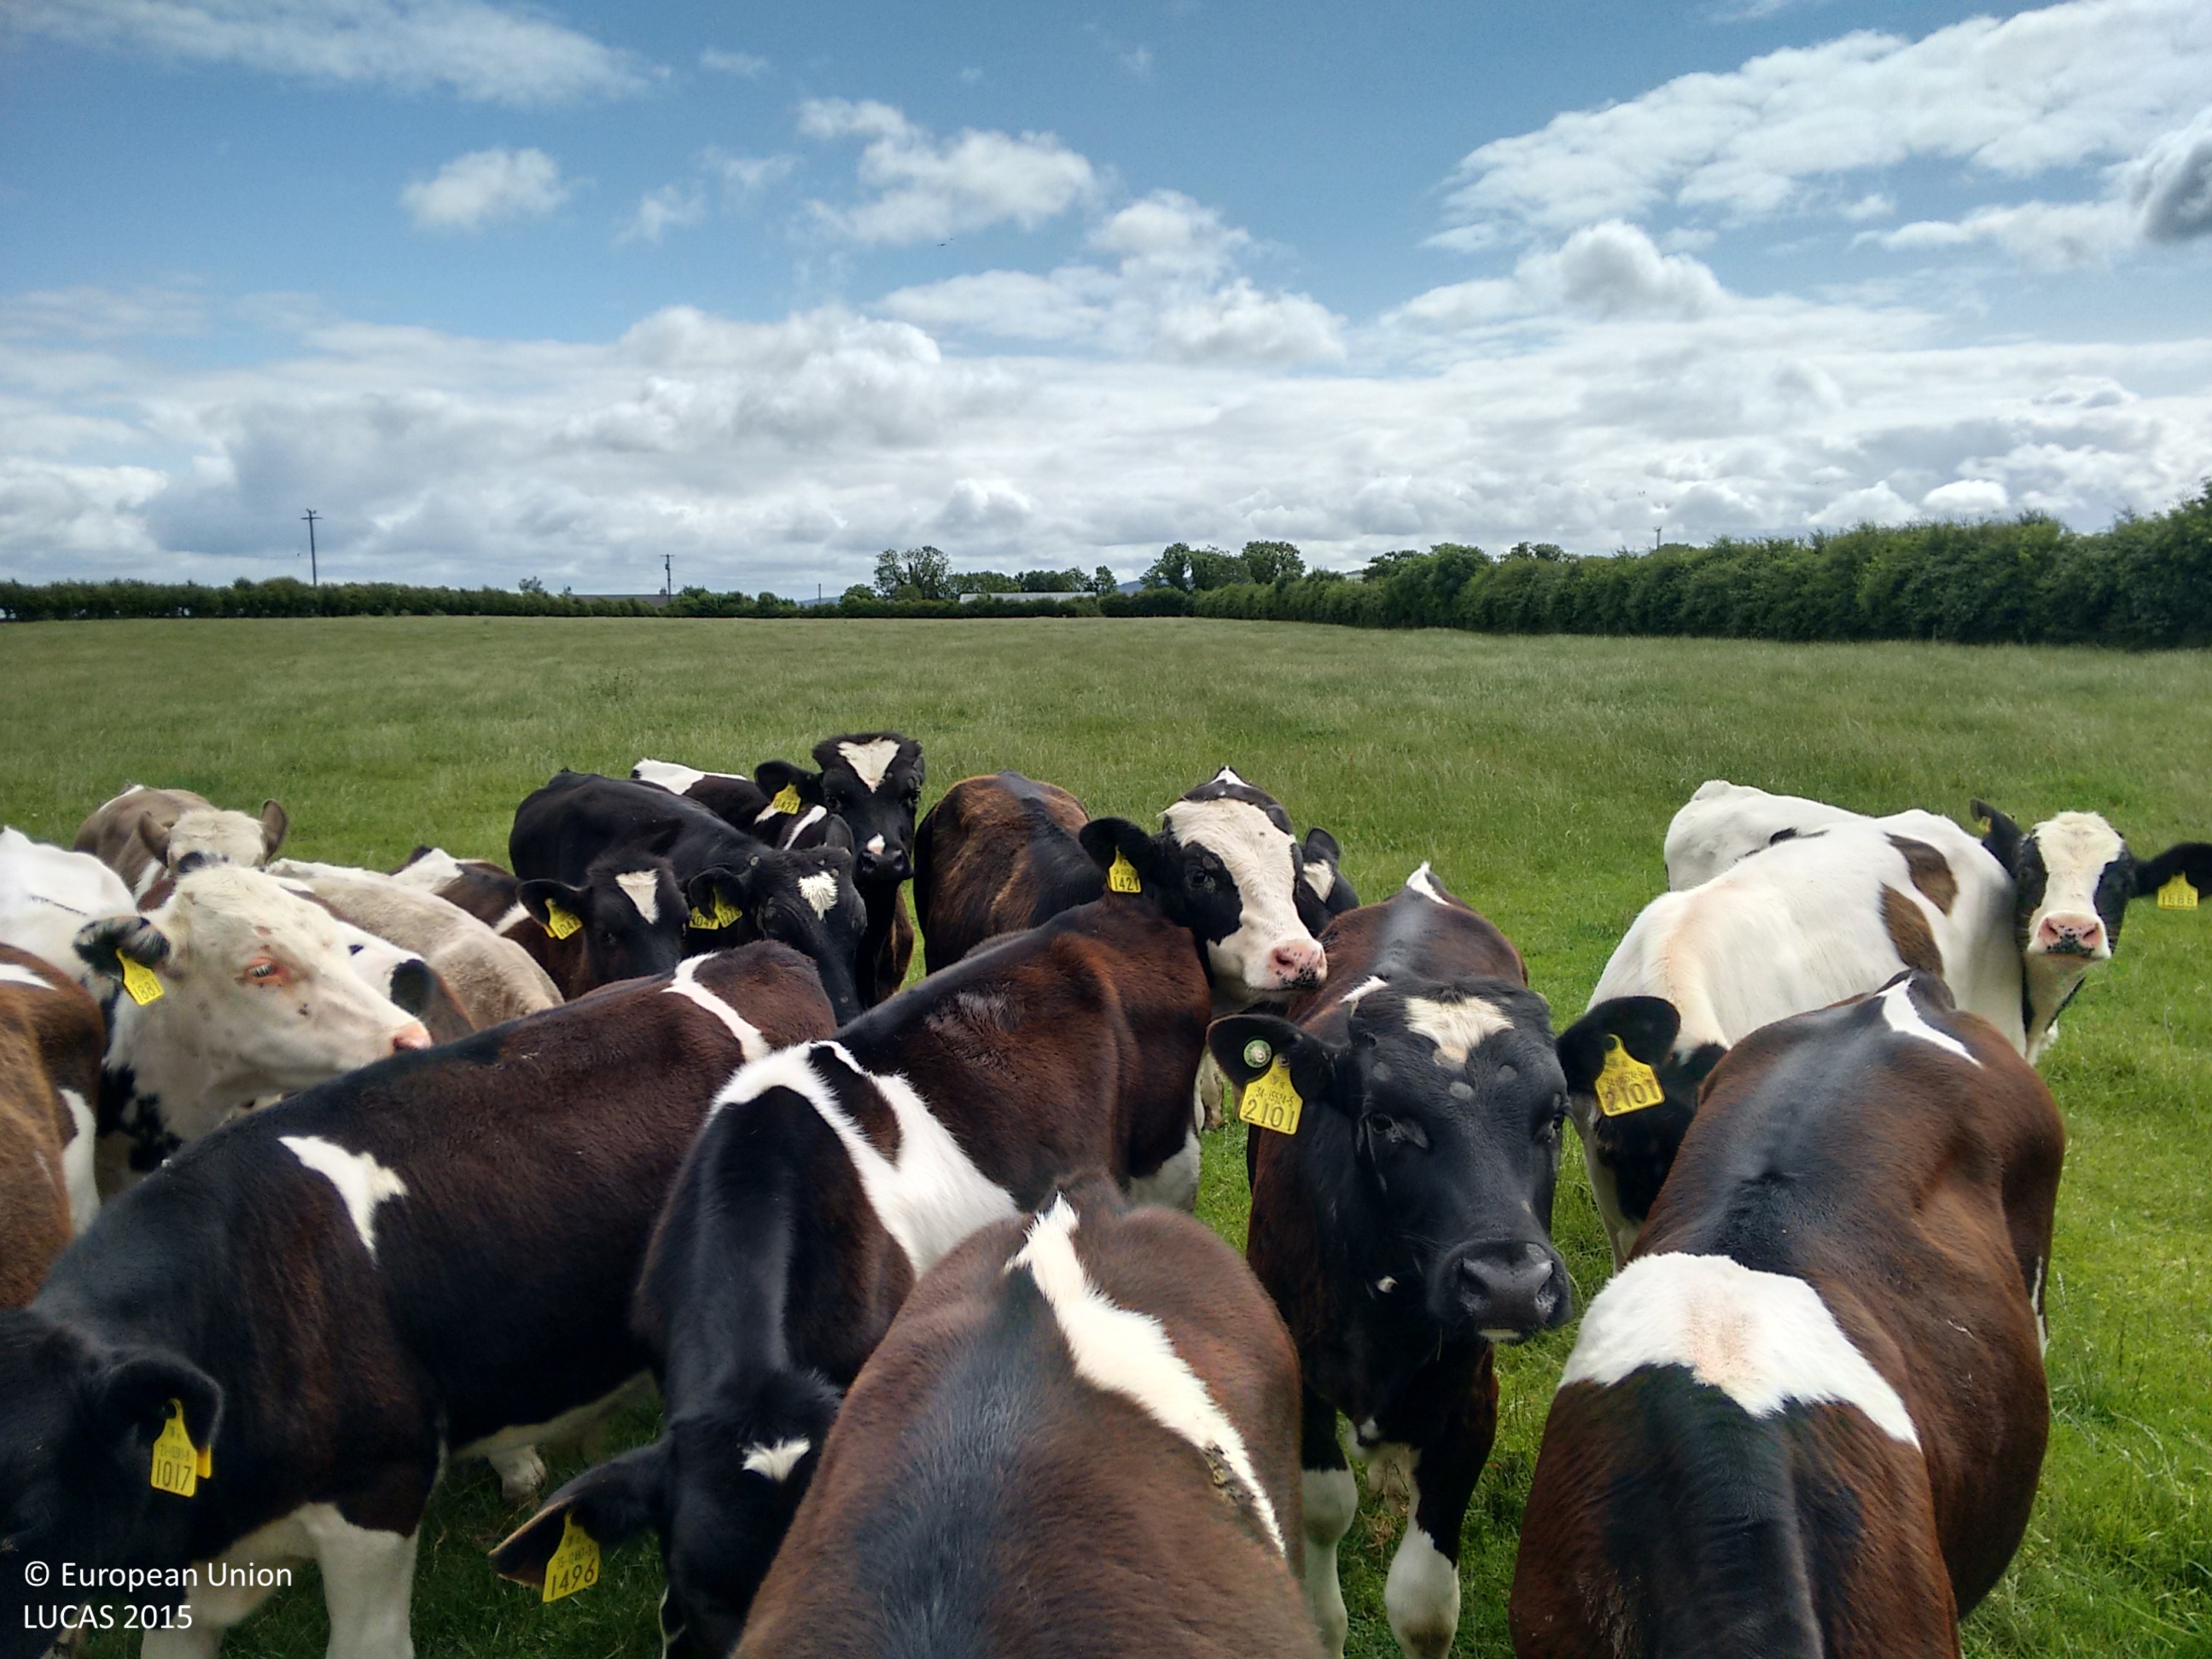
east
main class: Grassland
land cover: Grassland without tree/shrub cover
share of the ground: > 75 %
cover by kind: herbaceous plants 100 %
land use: Agriculture (excluding fallow land and kitchen gardens)
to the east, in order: Grassland without tree/shrub cover; Fences; Abandoned hedges; Tracks; Fences; Grassland without tree/shrub cover
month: July
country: IE
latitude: 52.8038
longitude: -7.5604
